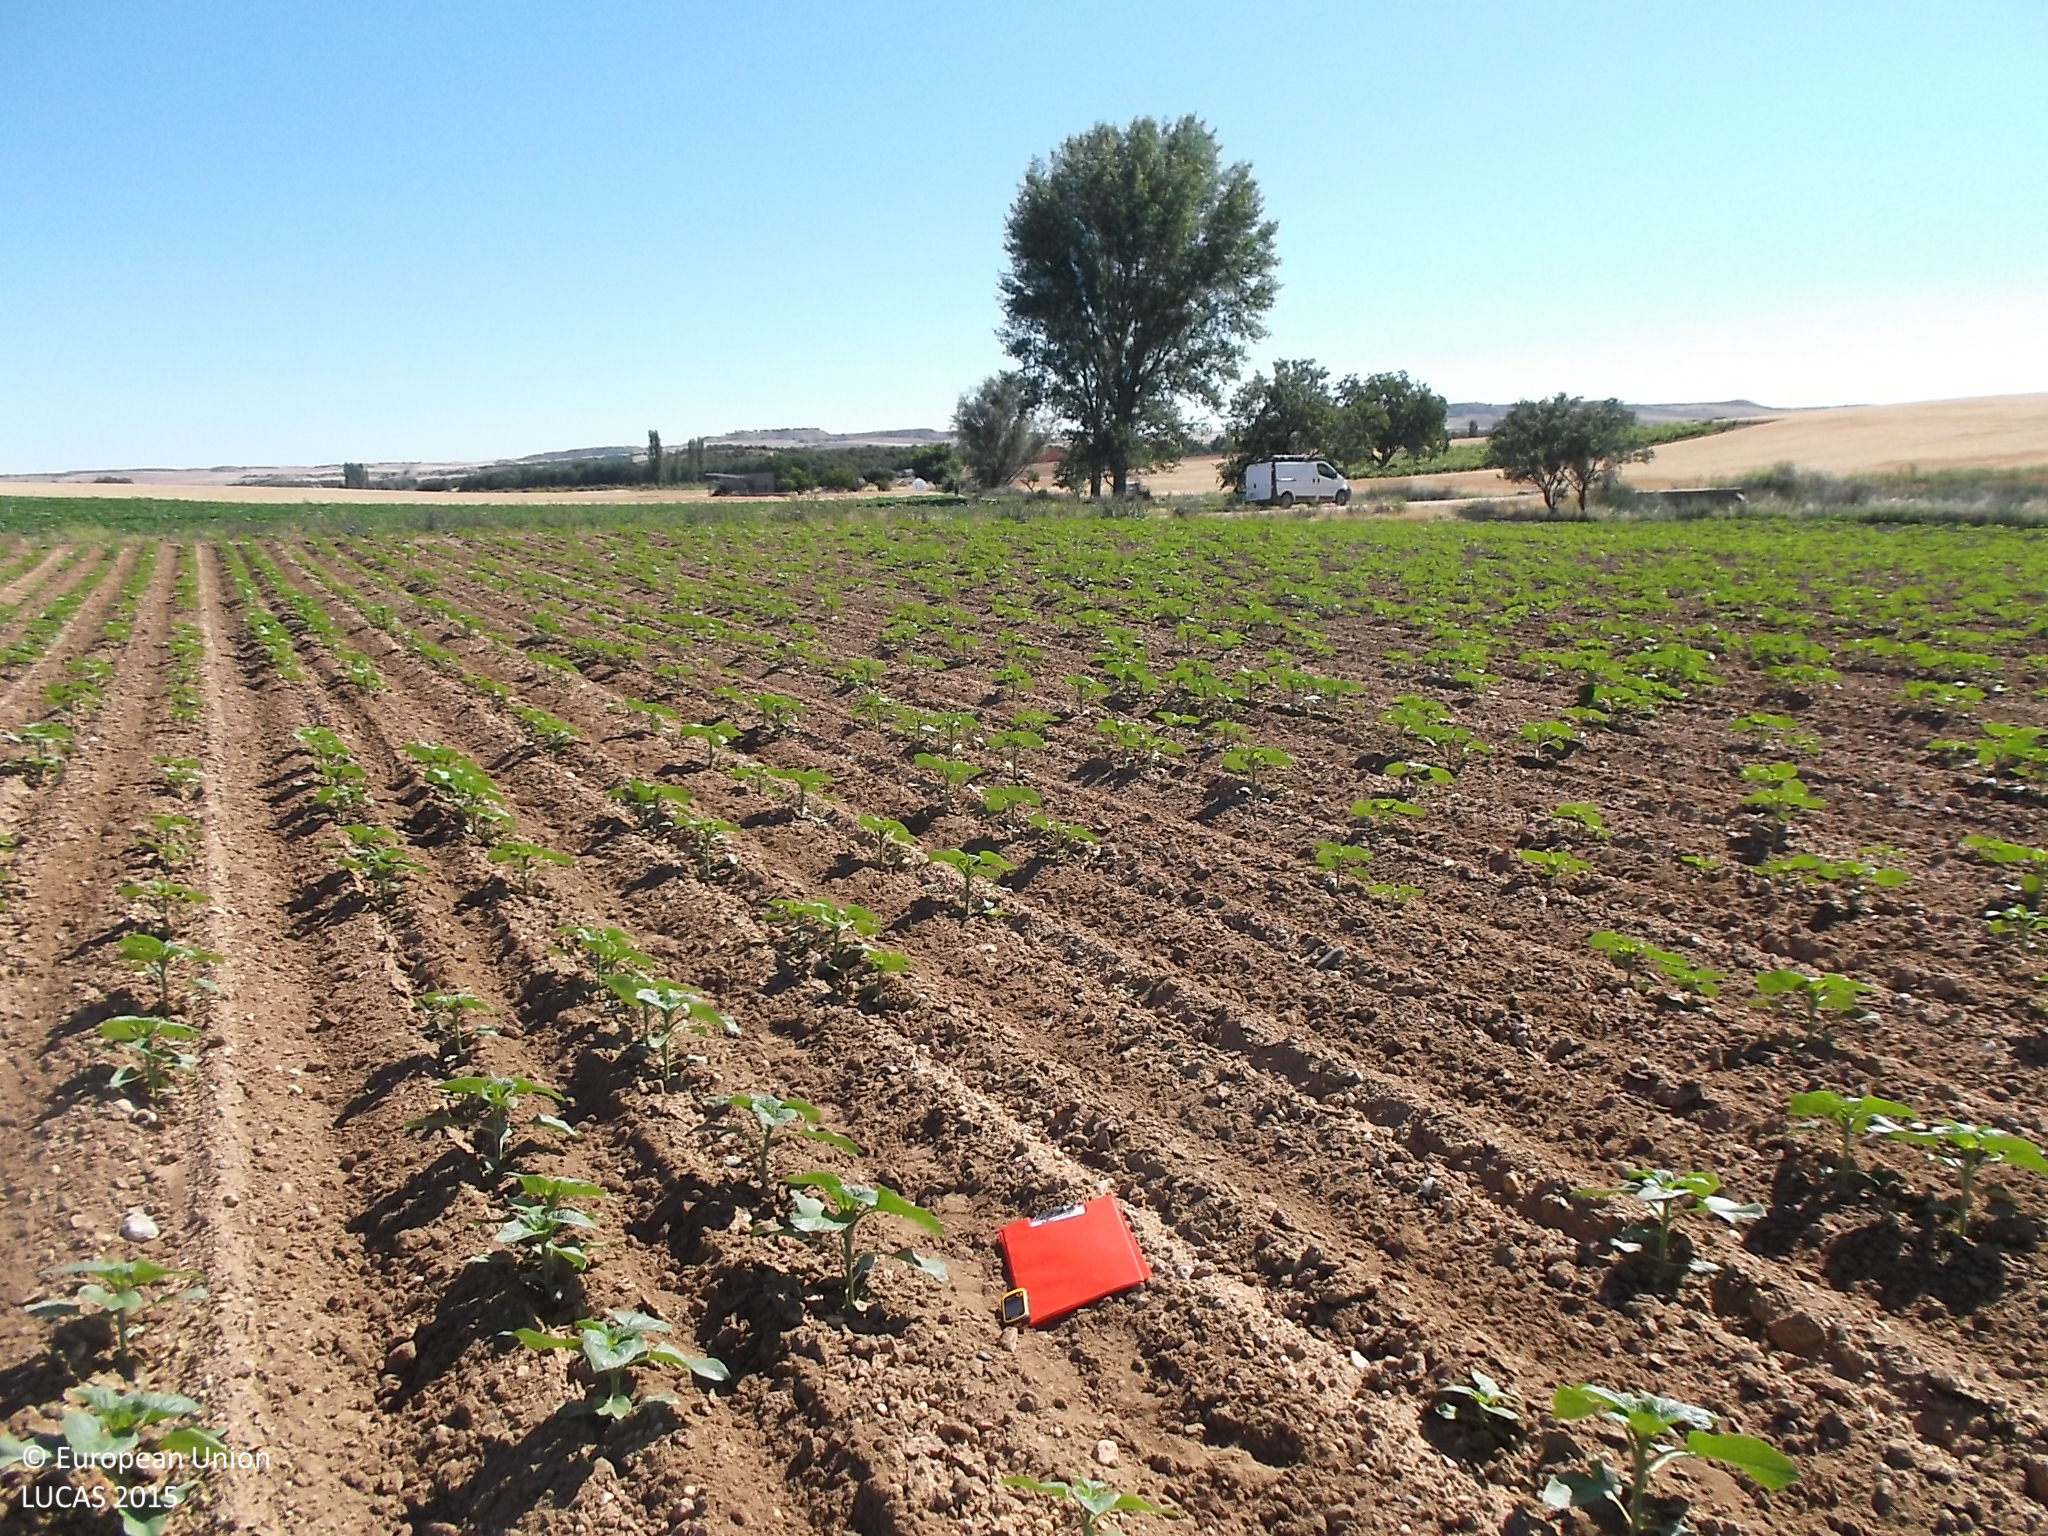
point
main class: Cropland
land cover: Sunflower
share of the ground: 50 - 75 %
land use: Agriculture (excluding fallow land and kitchen gardens)
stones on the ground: < 10 %
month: June
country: ES
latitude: 41.2535
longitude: -5.3634
